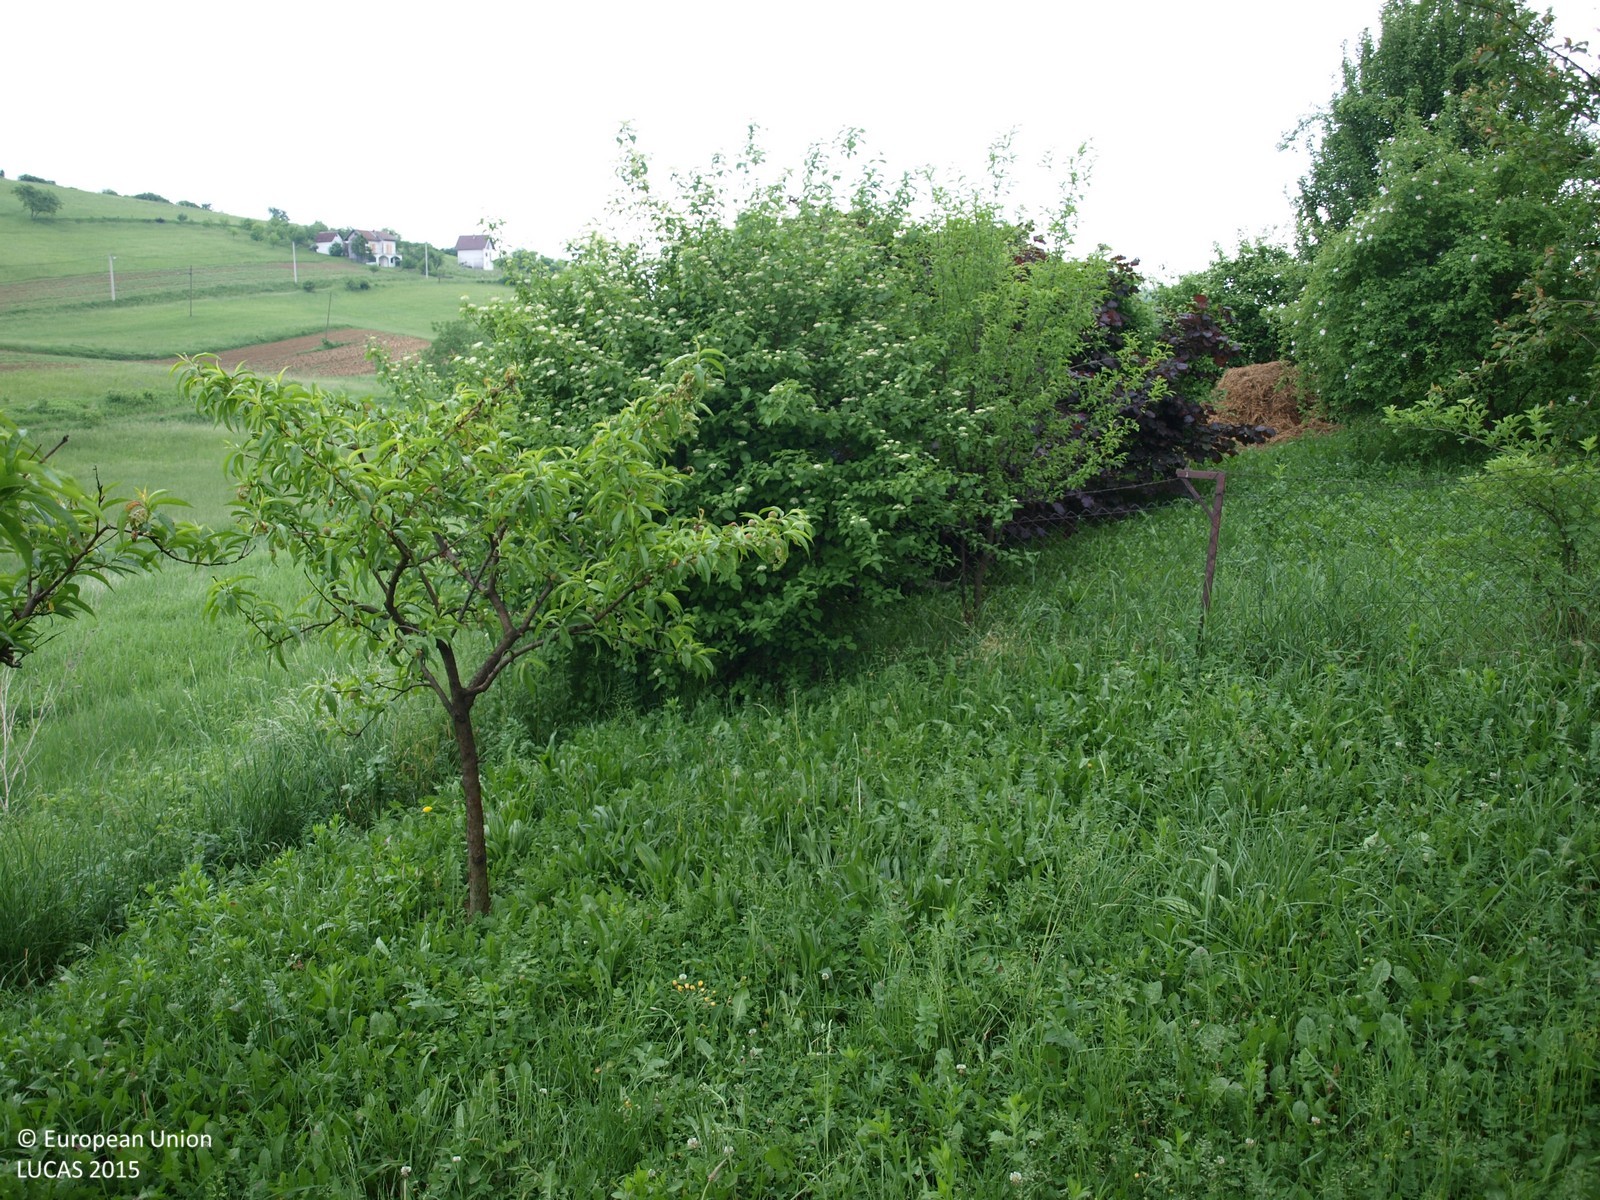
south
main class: Cropland
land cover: Other fruit trees and berries
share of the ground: 25 - 50 %
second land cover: Grassland without tree/shrub cover
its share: > 75 %
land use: Kitchen garden
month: May
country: HR
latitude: 46.1128
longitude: 16.2747
